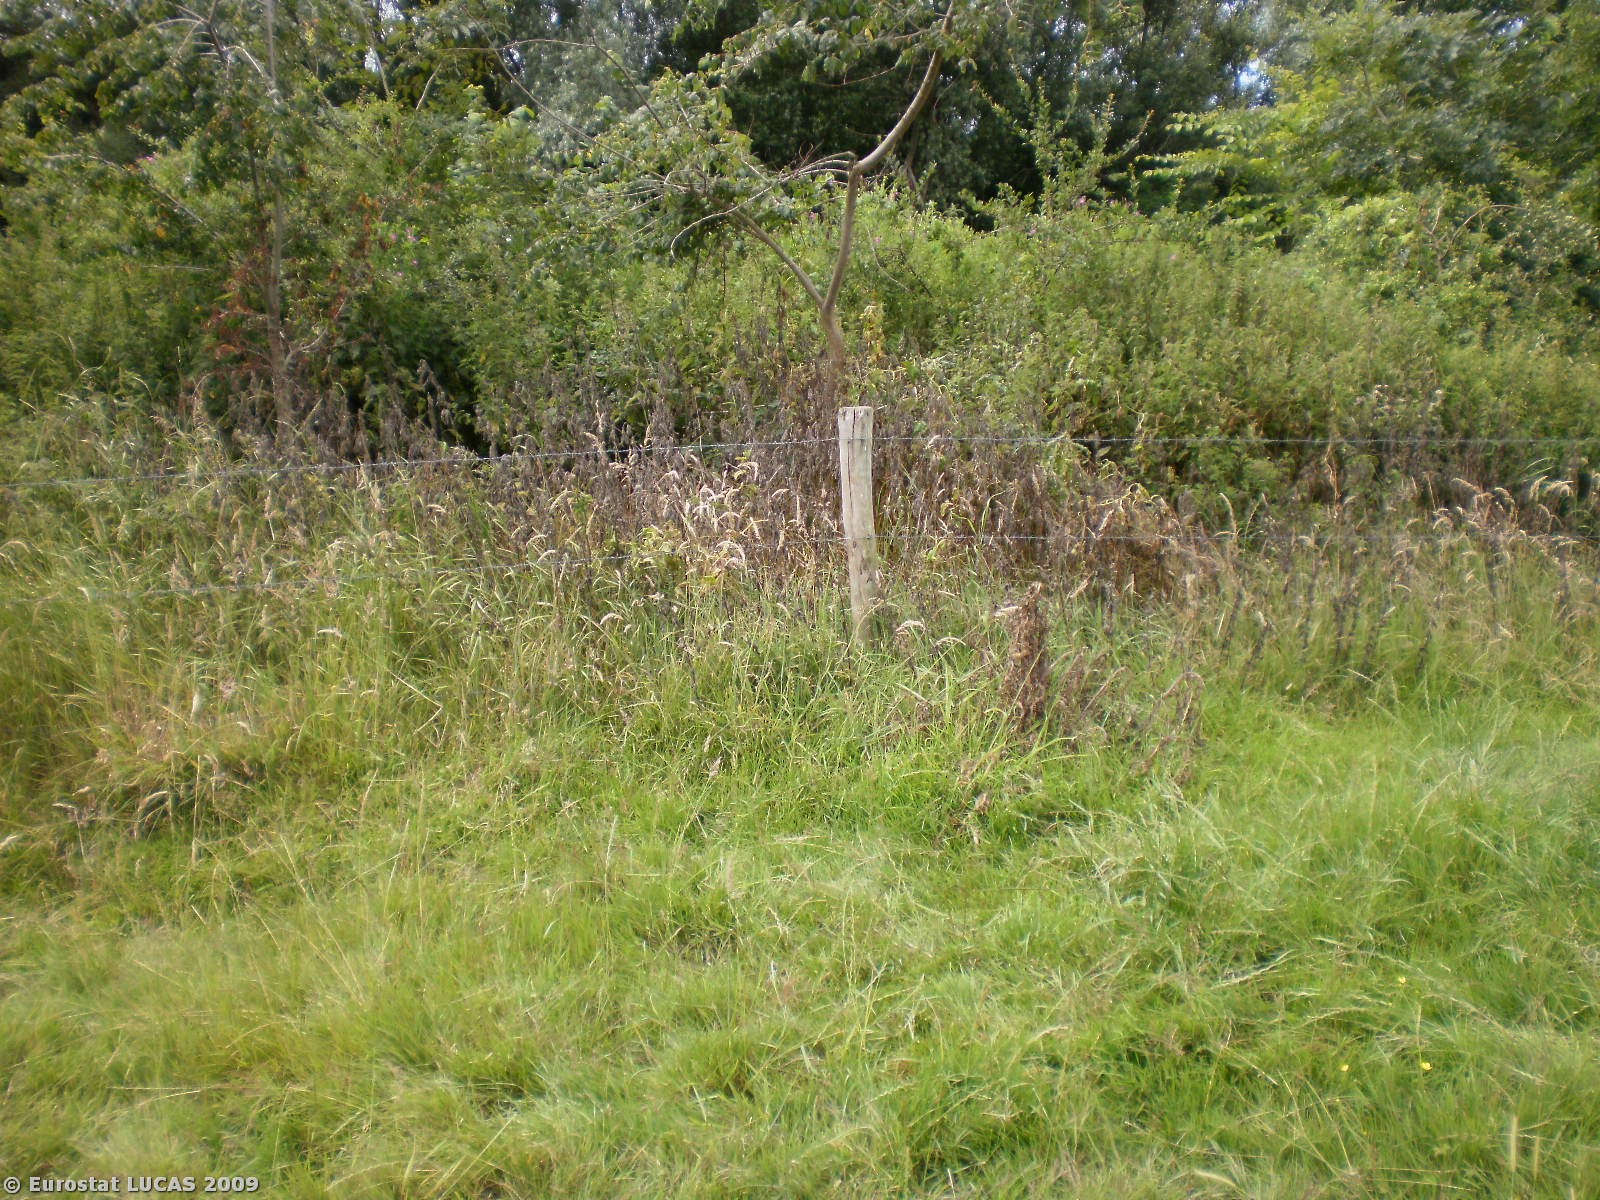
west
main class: Grassland
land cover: Grassland without tree/shrub cover
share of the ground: > 75 %
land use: Agriculture (excluding fallow land and kitchen gardens)
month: July
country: BE
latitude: 51.3363
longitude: 3.2302
